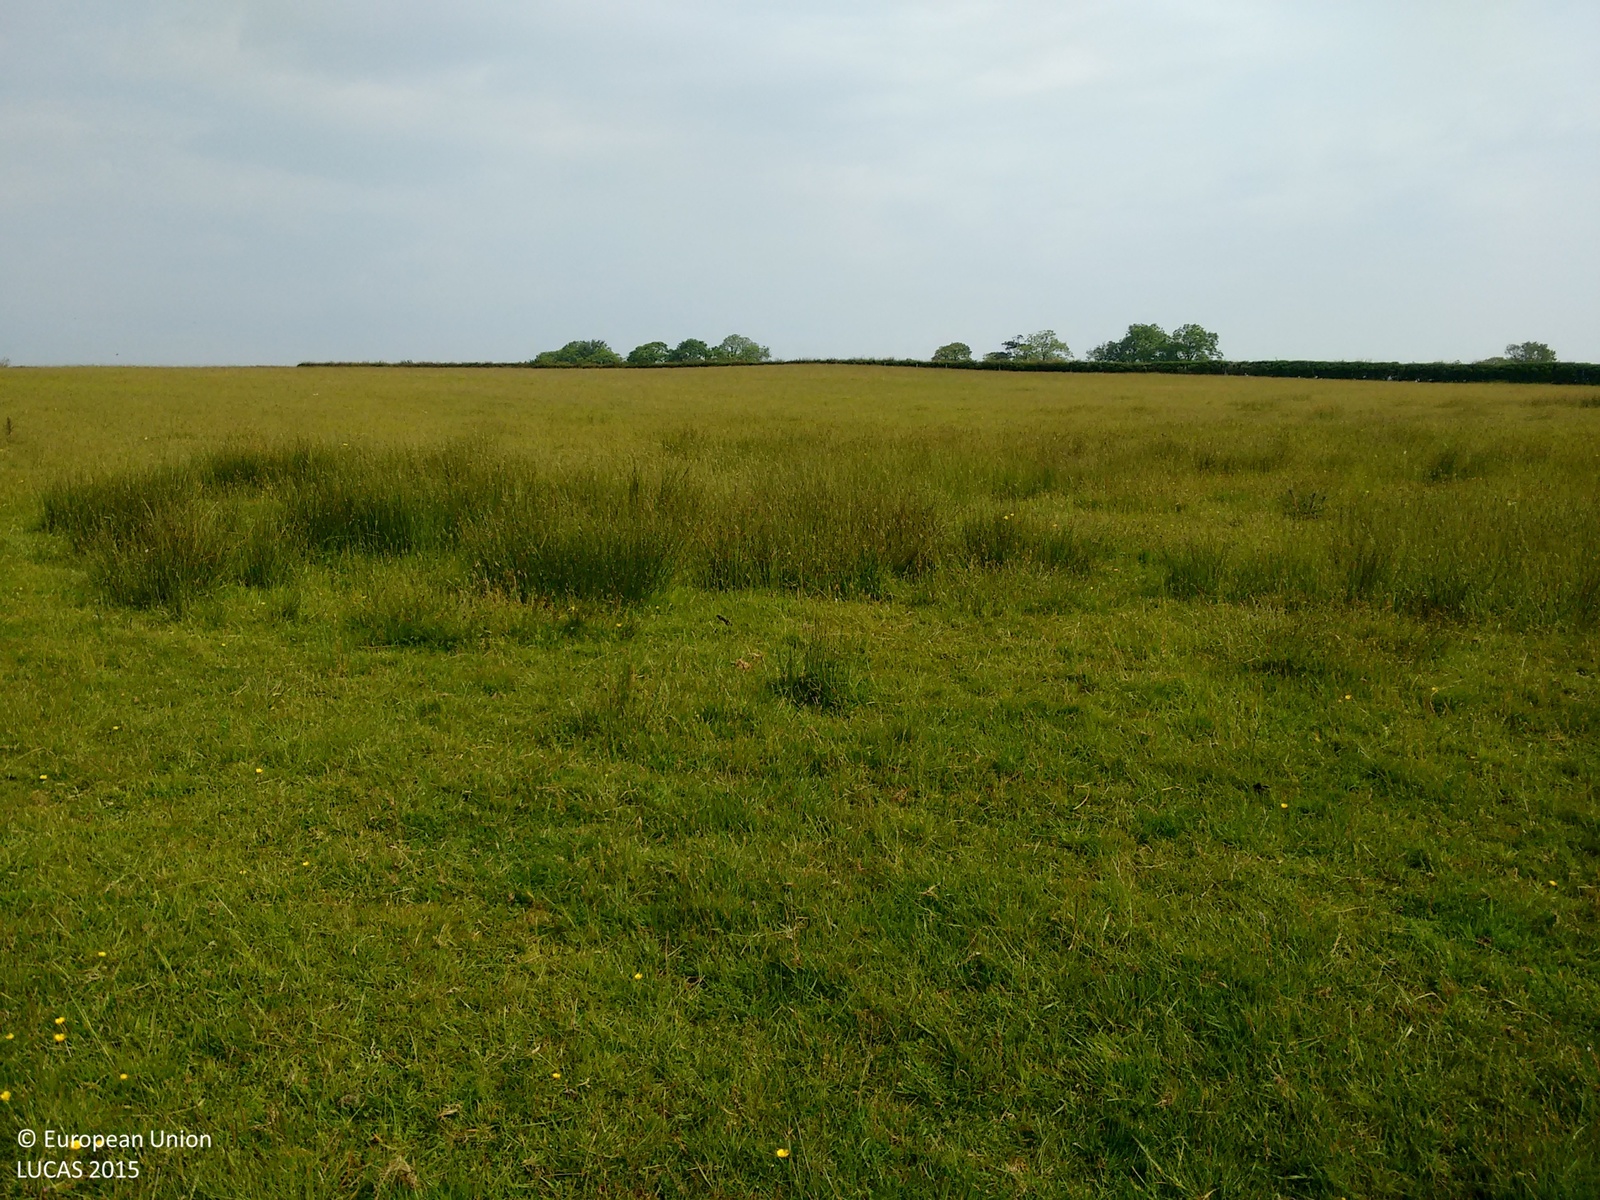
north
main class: Grassland
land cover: Grassland without tree/shrub cover
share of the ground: > 75 %
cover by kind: herbaceous plants 100 %
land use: Agriculture (excluding fallow land and kitchen gardens)
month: June
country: GB
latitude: 50.9653
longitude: 0.3020
